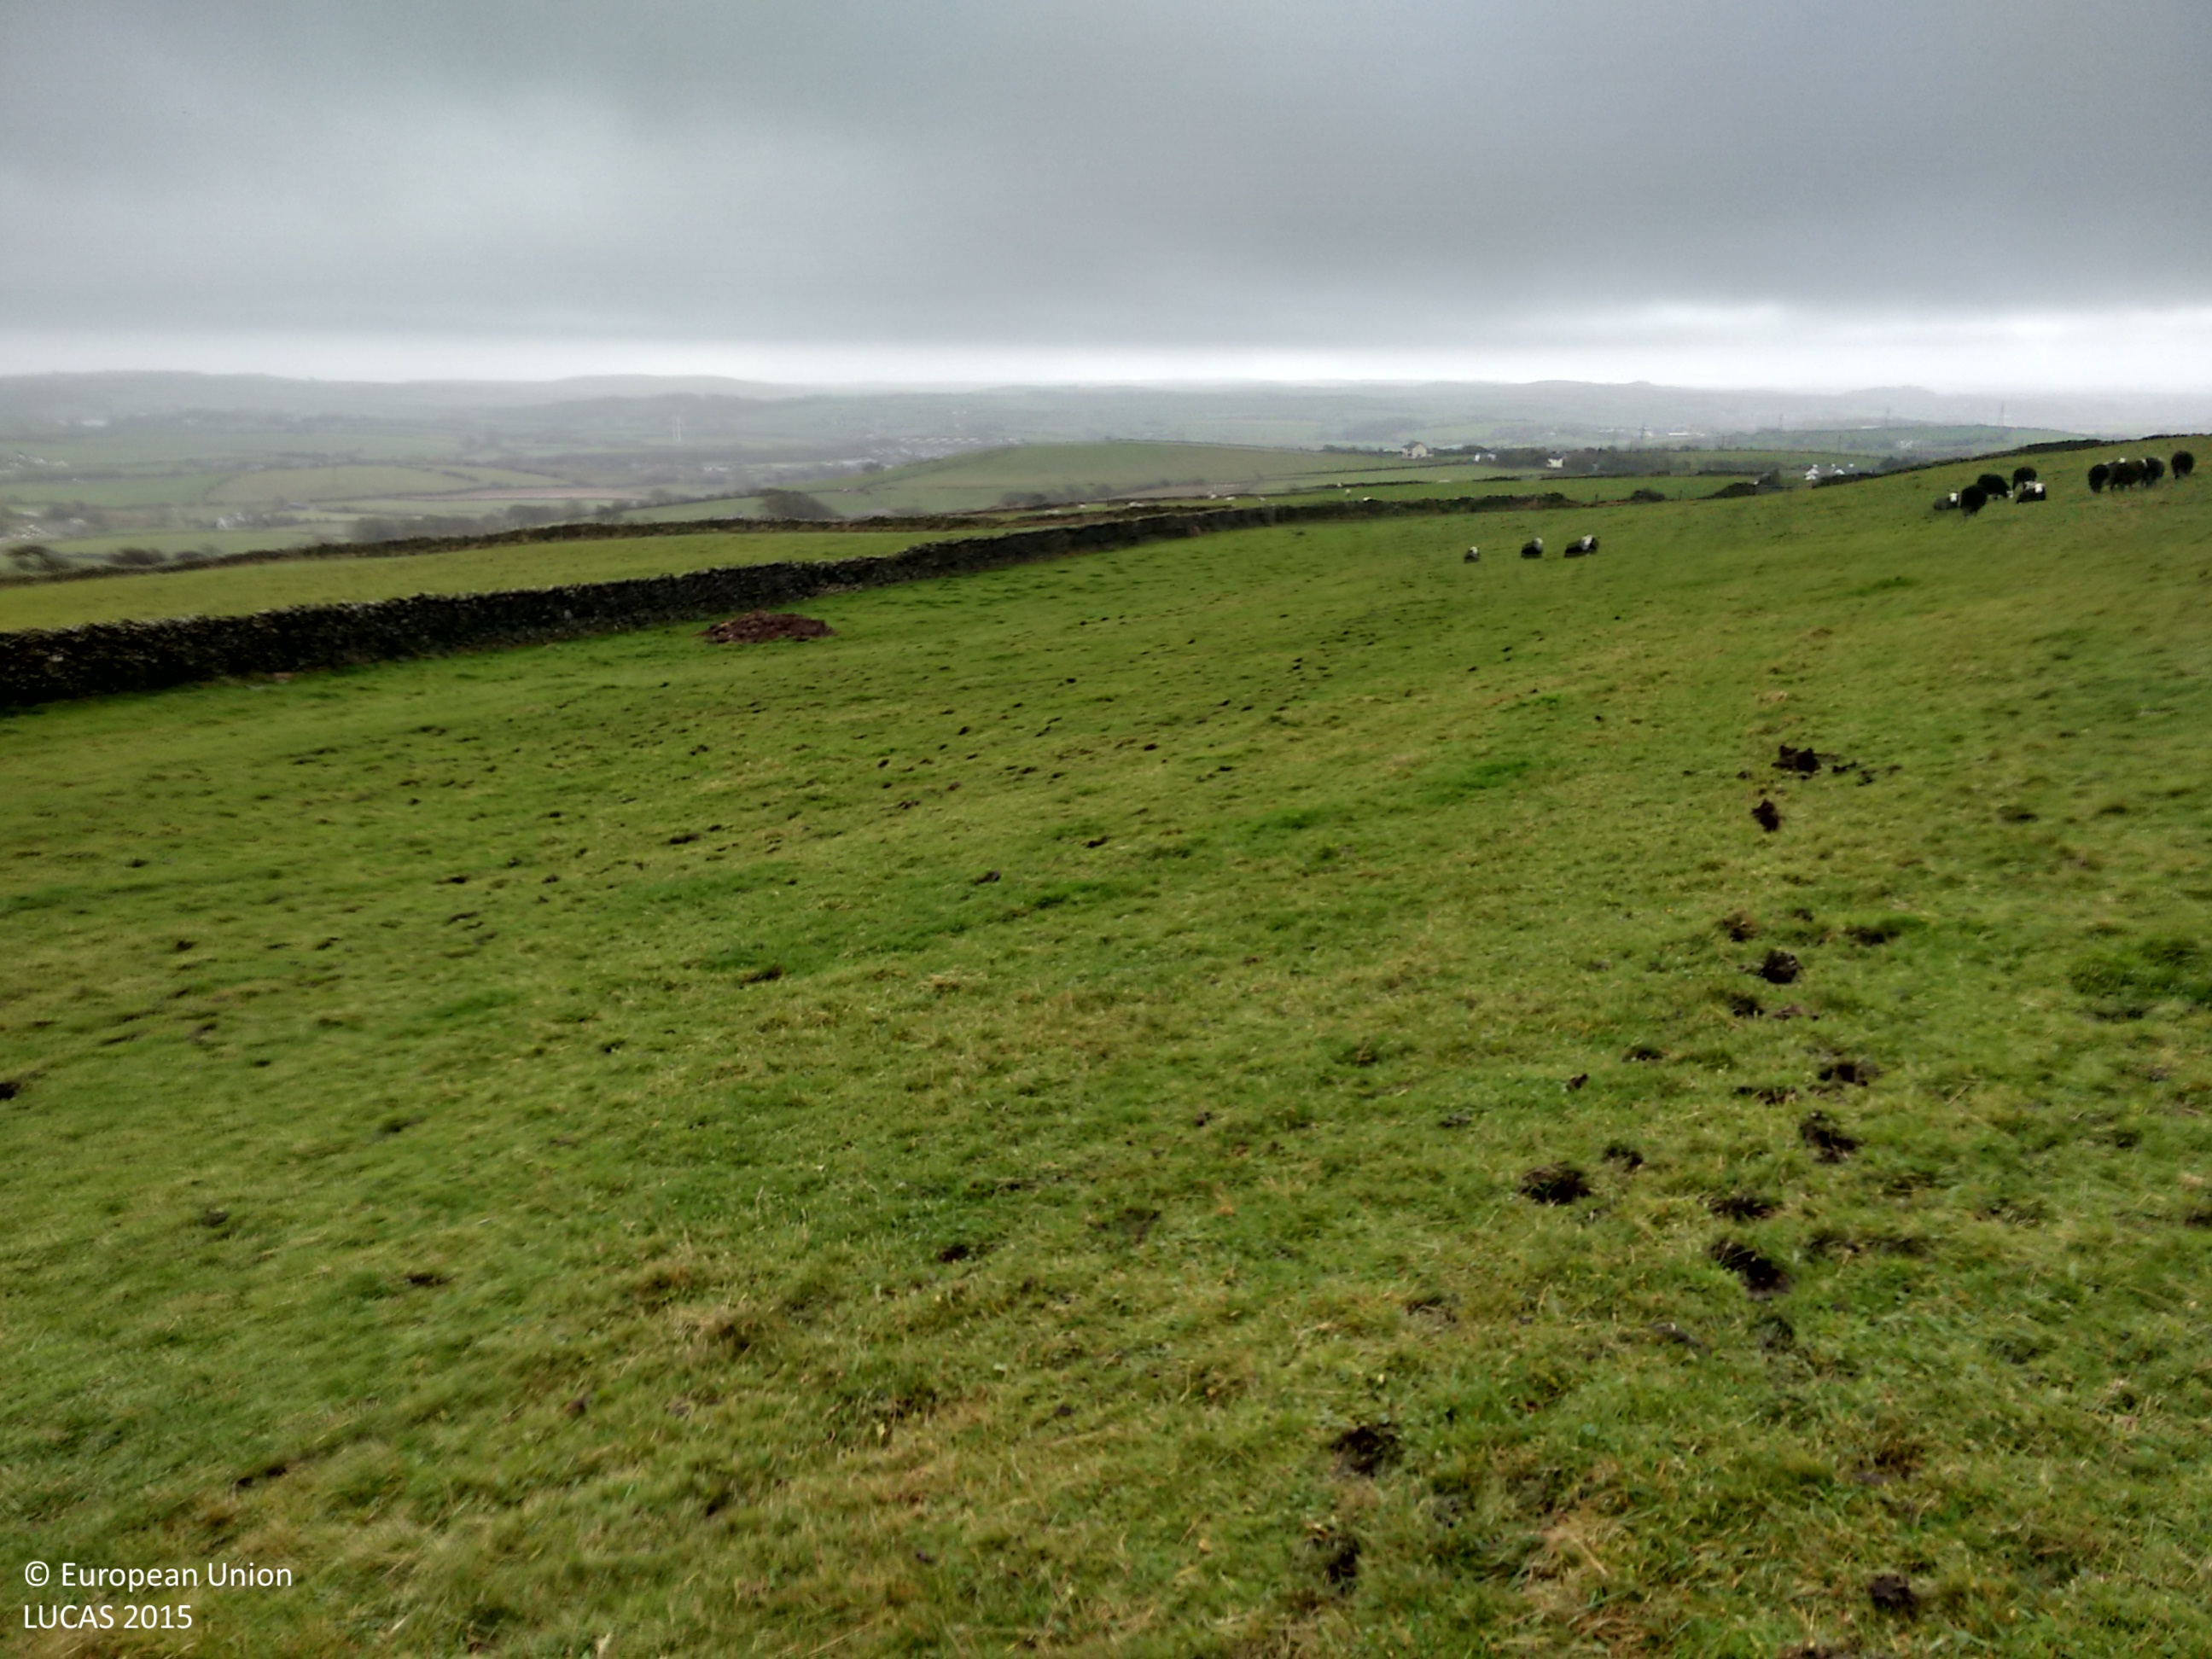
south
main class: Grassland
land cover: Grassland without tree/shrub cover
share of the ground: > 75 %
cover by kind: herbaceous plants 100 %
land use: Agriculture (excluding fallow land and kitchen gardens)
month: November
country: GB
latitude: 54.1940
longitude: -3.1498
